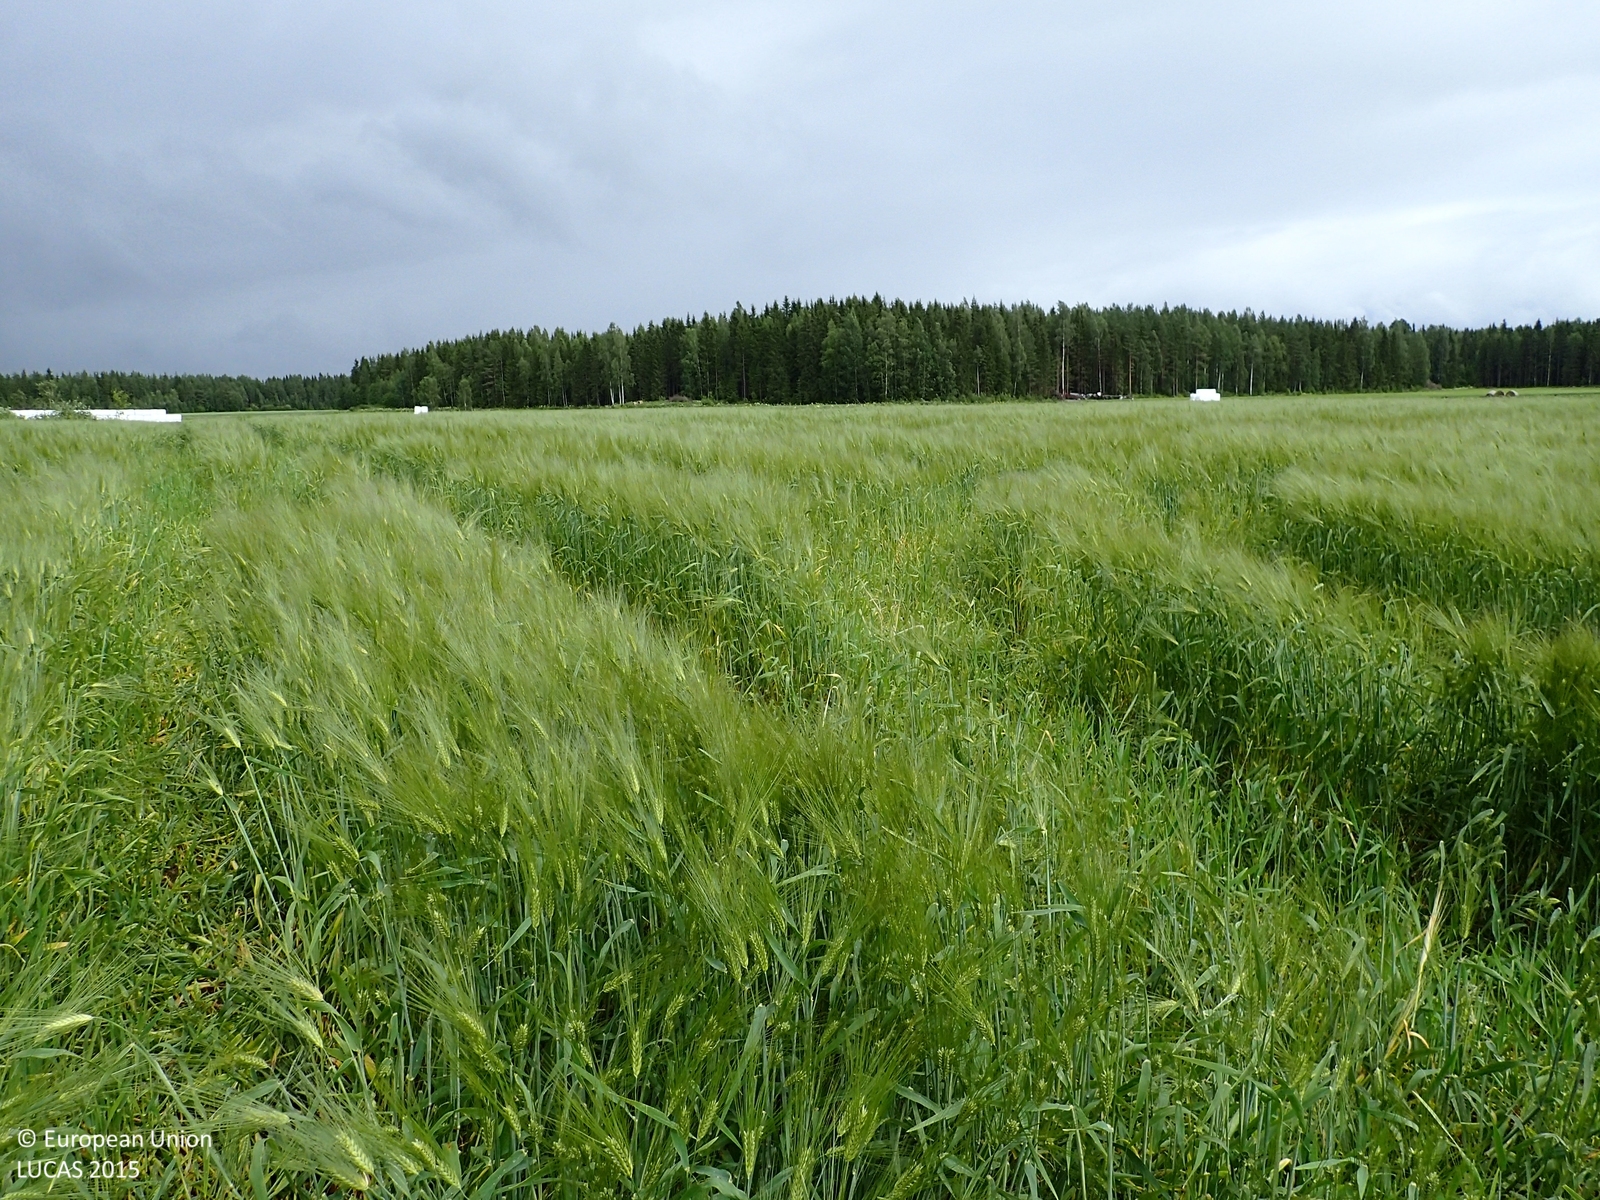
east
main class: Cropland
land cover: Oats
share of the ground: > 75 %
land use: Agriculture (excluding fallow land and kitchen gardens)
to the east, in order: Oats; Barley; Grass margins; Ditches and canals; Temporary grasslands
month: July
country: FI
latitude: 62.8248
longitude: 22.6751
